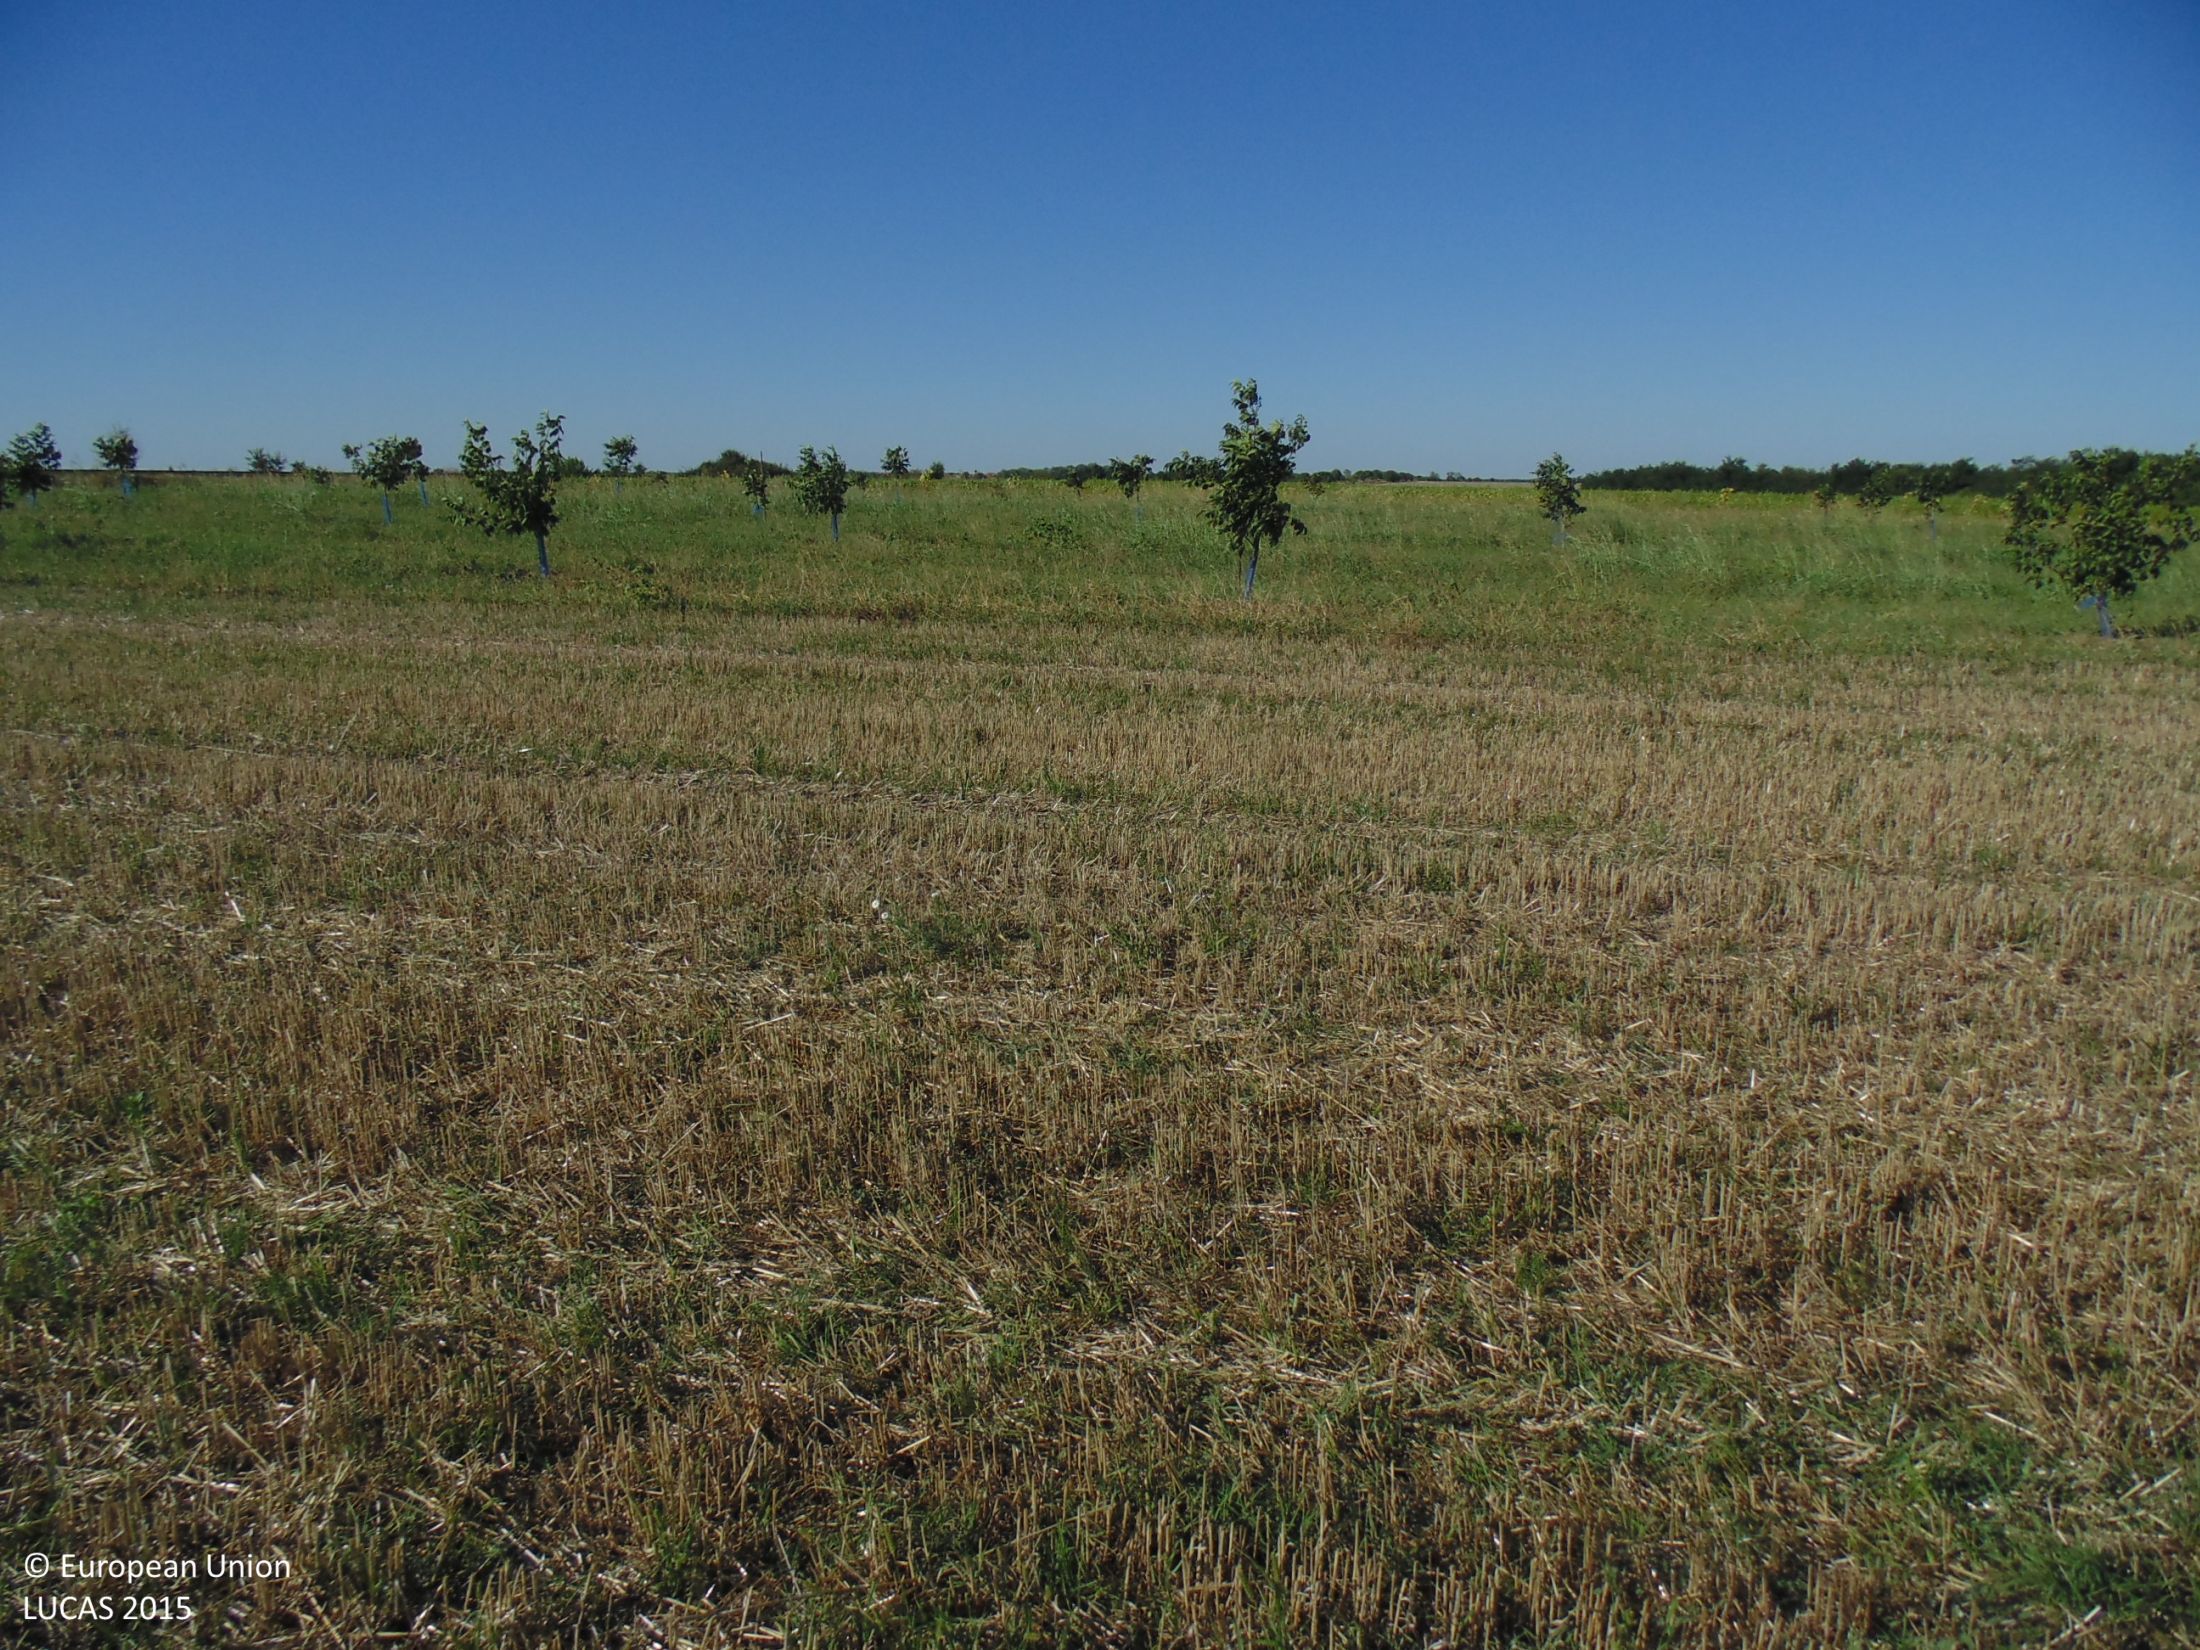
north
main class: Cropland
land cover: Common wheat
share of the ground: 25 - 50 %
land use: Agriculture (excluding fallow land and kitchen gardens)
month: September
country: BG
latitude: 43.8220
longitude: 27.1981
